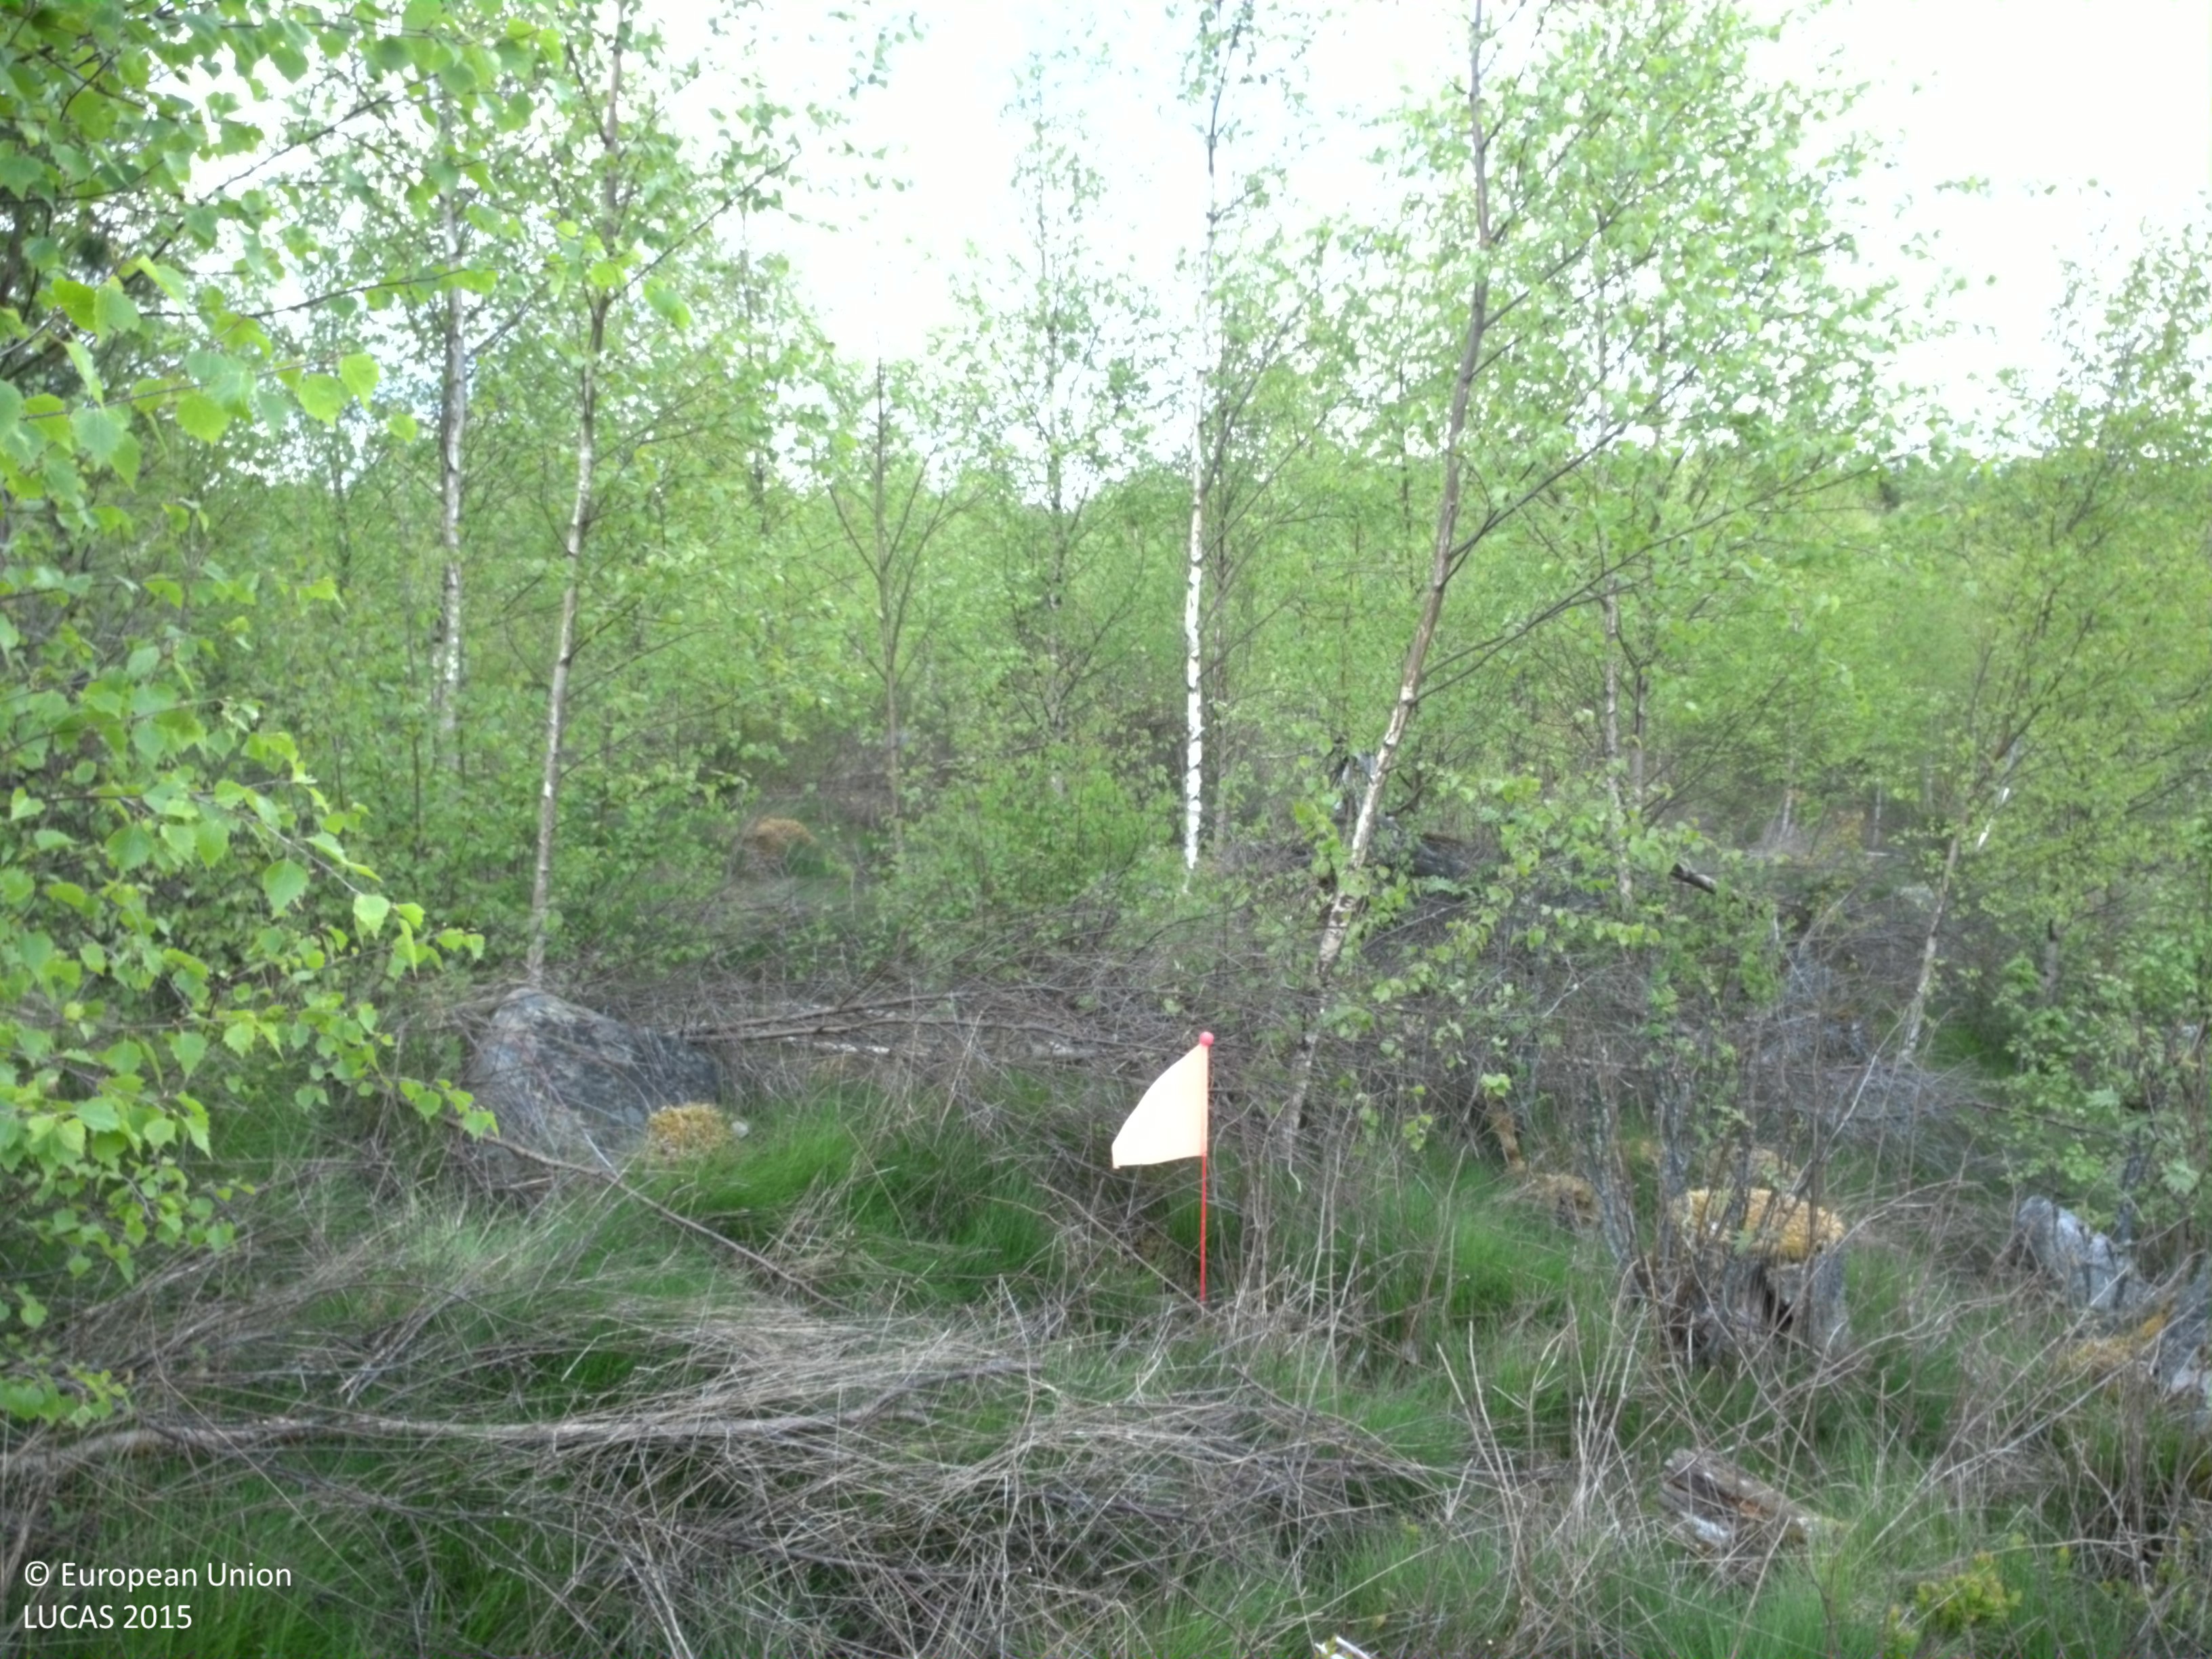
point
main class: Woodland
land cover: Broadleaved woodland
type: boreal forest
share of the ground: 50 - 75 %
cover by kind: broadleaved forest trees 60 %, herbaceous plants 30 %, coniferous forest trees 10 %
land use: Forestry
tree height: > 5 m
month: May
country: SE
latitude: 56.7036
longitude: 14.4887
